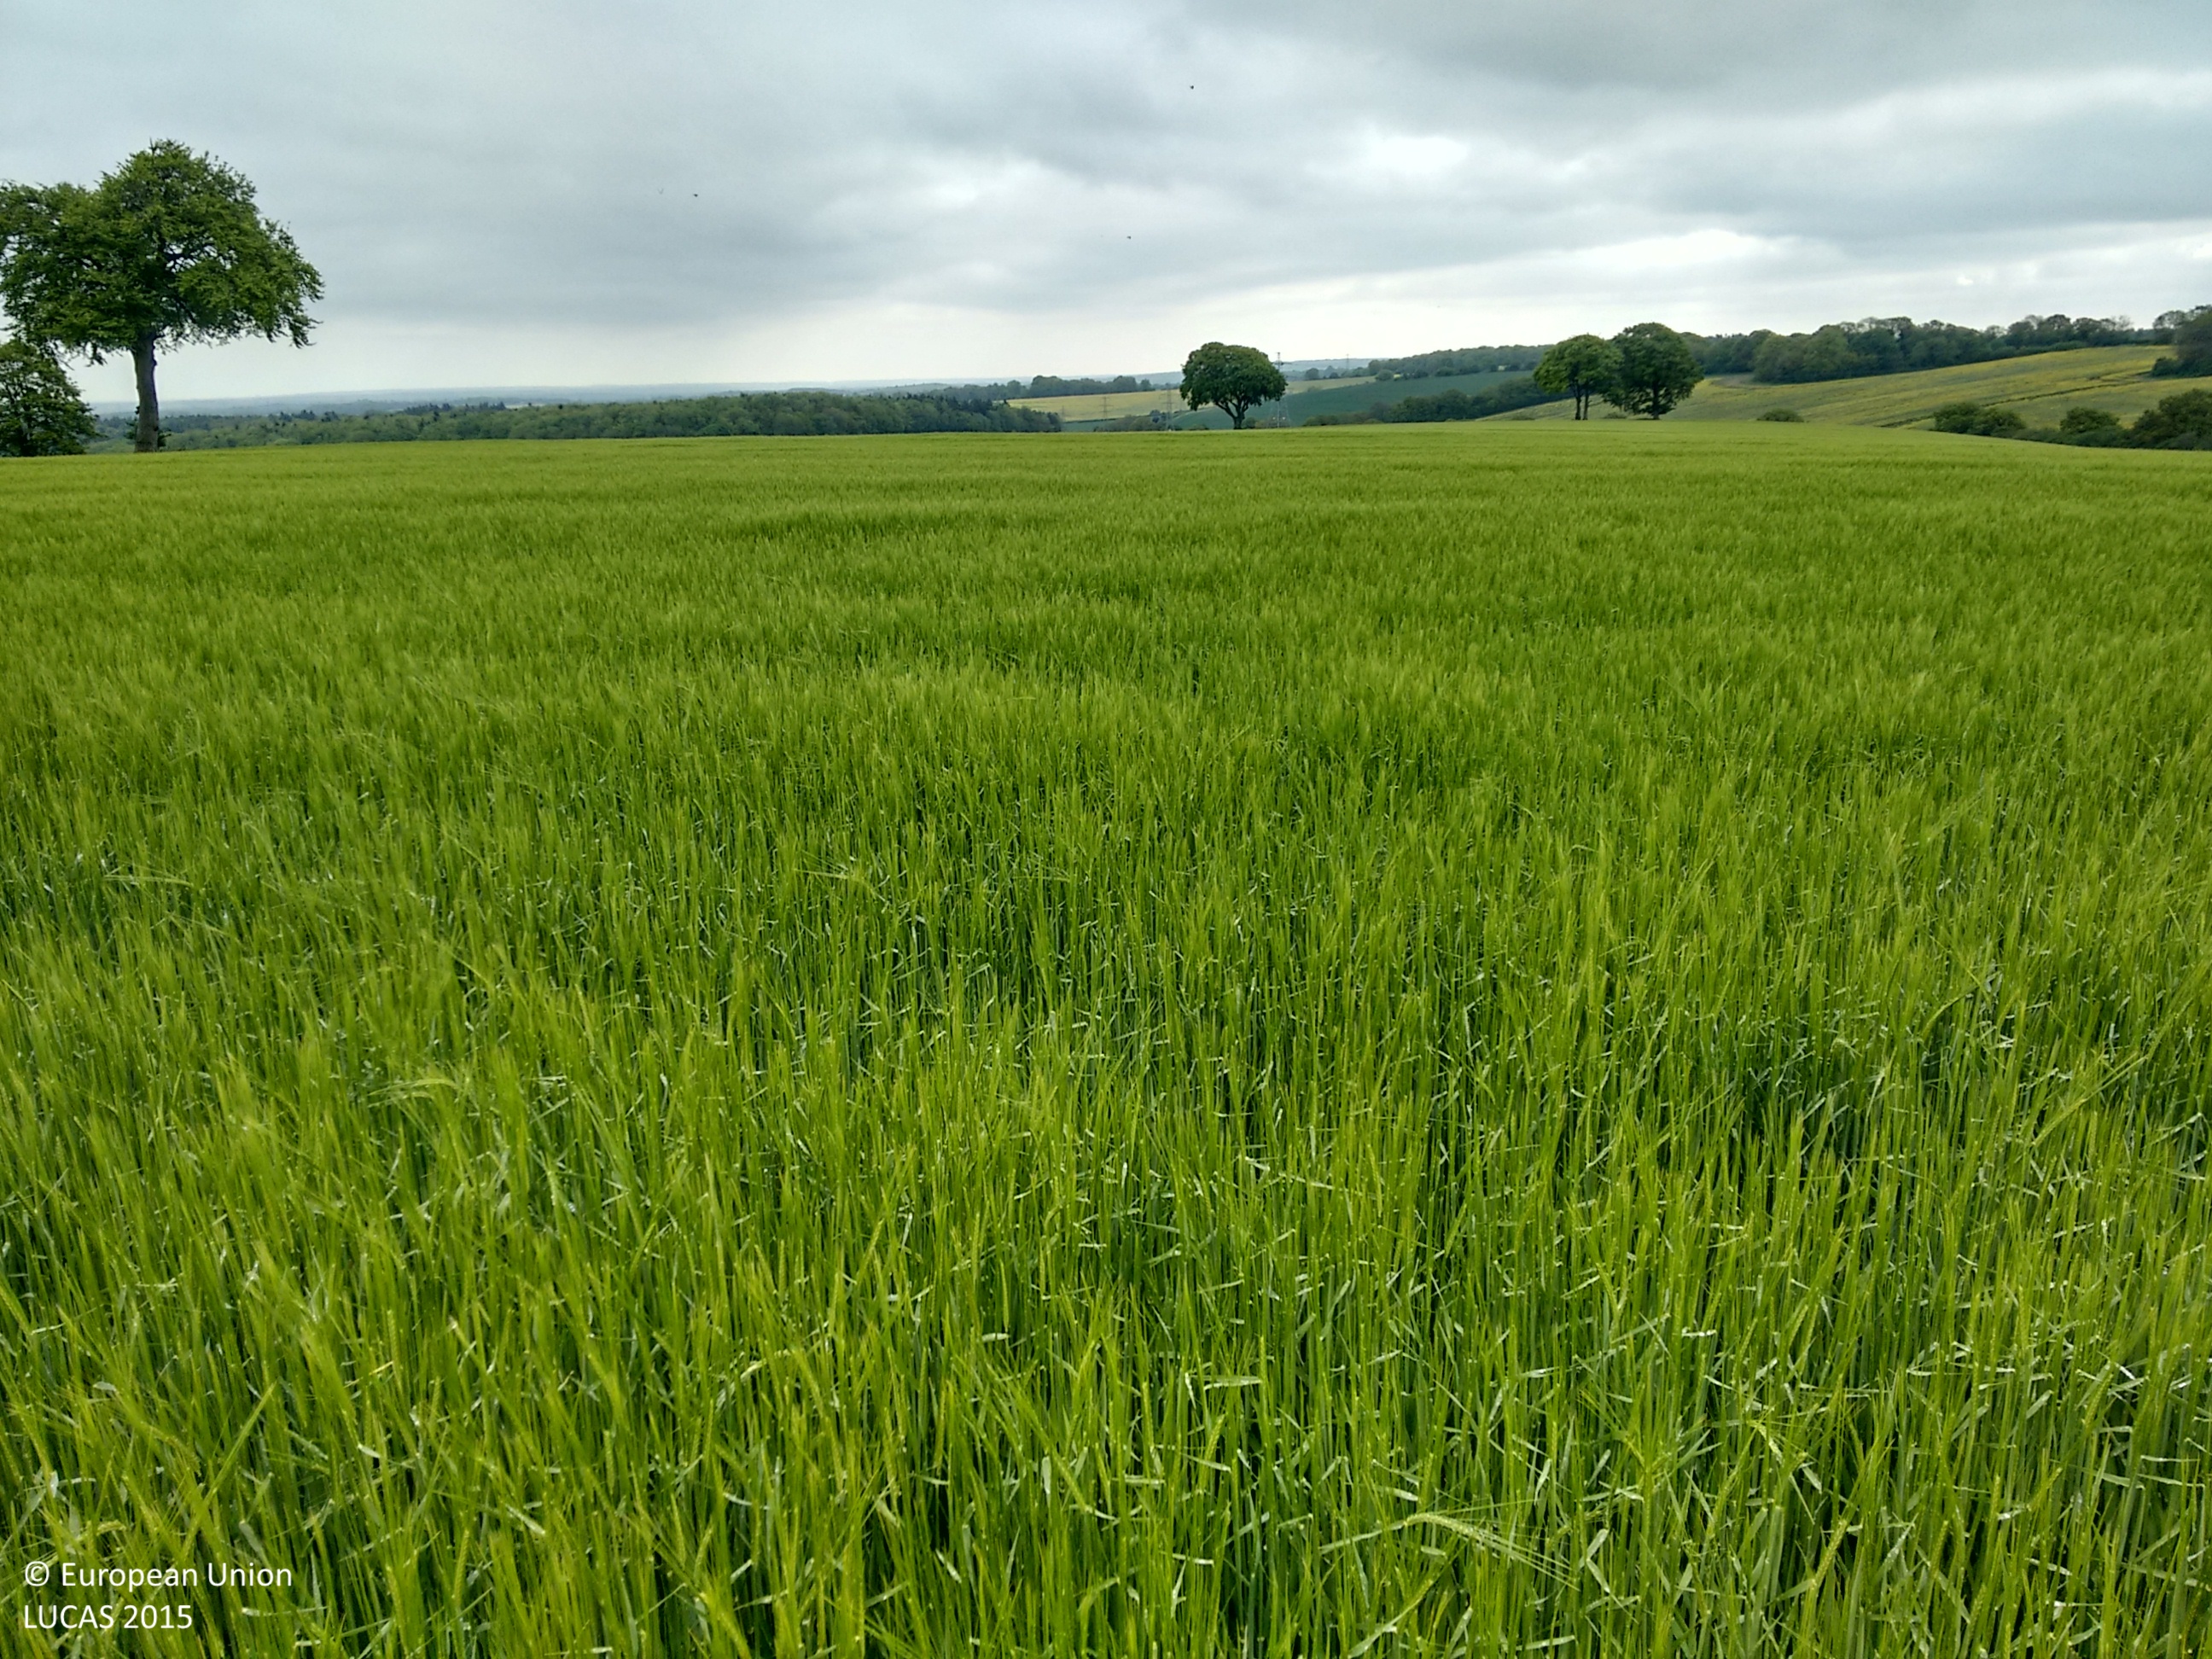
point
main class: Cropland
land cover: Barley
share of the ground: > 75 %
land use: Agriculture (excluding fallow land and kitchen gardens)
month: May
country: GB
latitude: 51.1966
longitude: -0.9628
